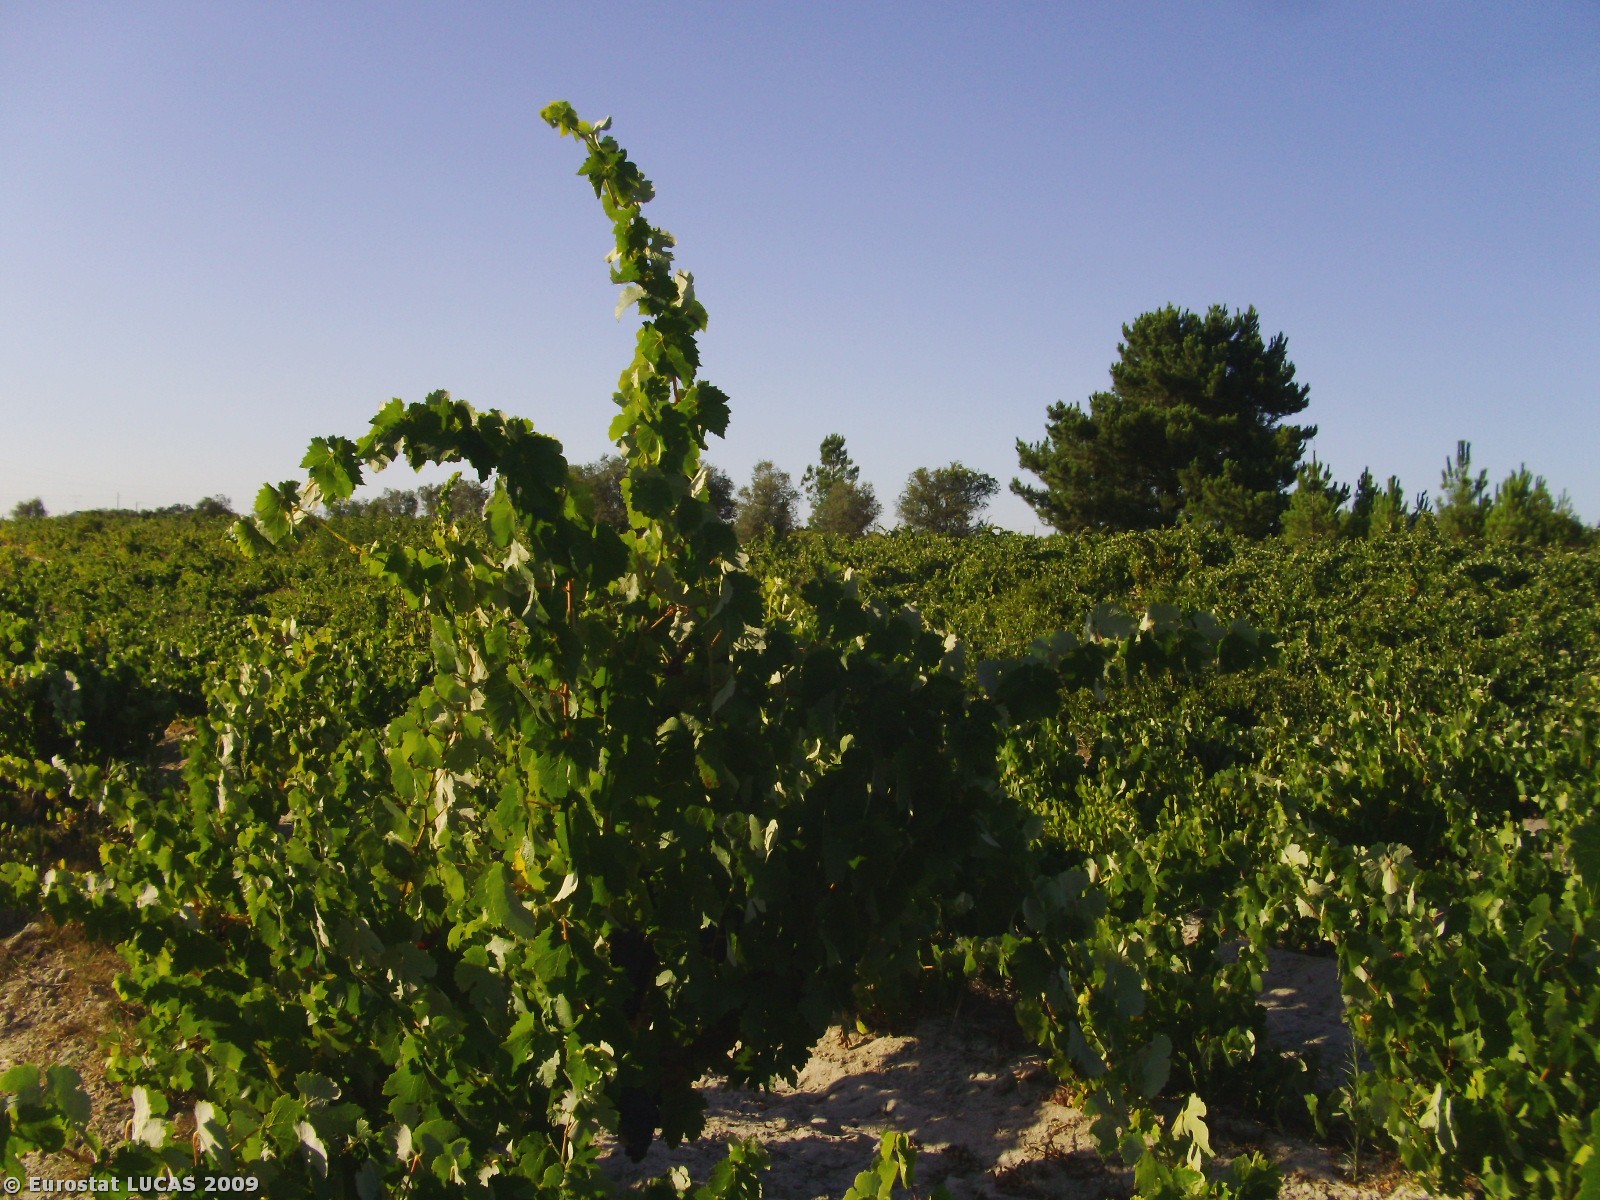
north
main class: Cropland
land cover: Vineyards
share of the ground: 25 - 50 %
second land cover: Bare land
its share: 25 - 50 %
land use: Agriculture (excluding fallow land and kitchen gardens)
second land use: Fallow land
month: August
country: PT
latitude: 38.6220
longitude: -8.6788
